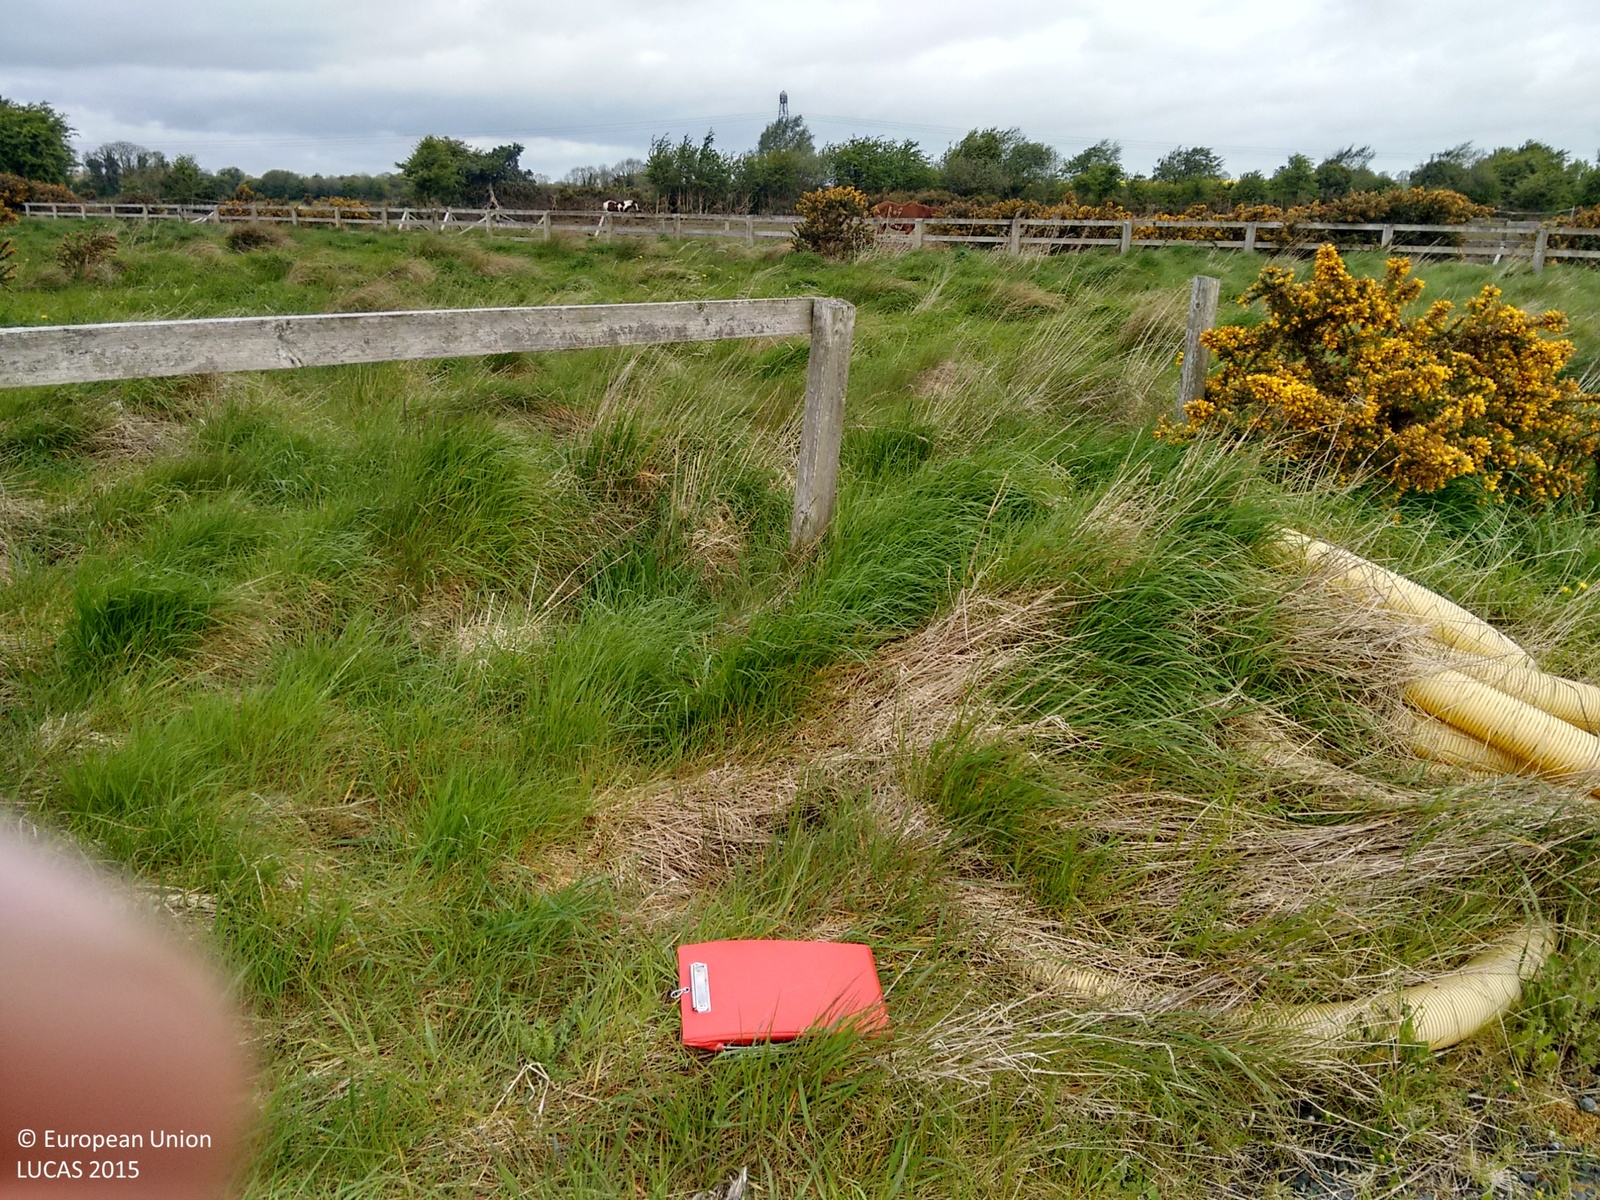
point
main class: Grassland
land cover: Grassland without tree/shrub cover
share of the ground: > 75 %
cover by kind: herbaceous plants 95 %, shrubs 5 %
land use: Abandoned areas
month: May
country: IE
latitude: 53.3206
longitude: -6.6600
